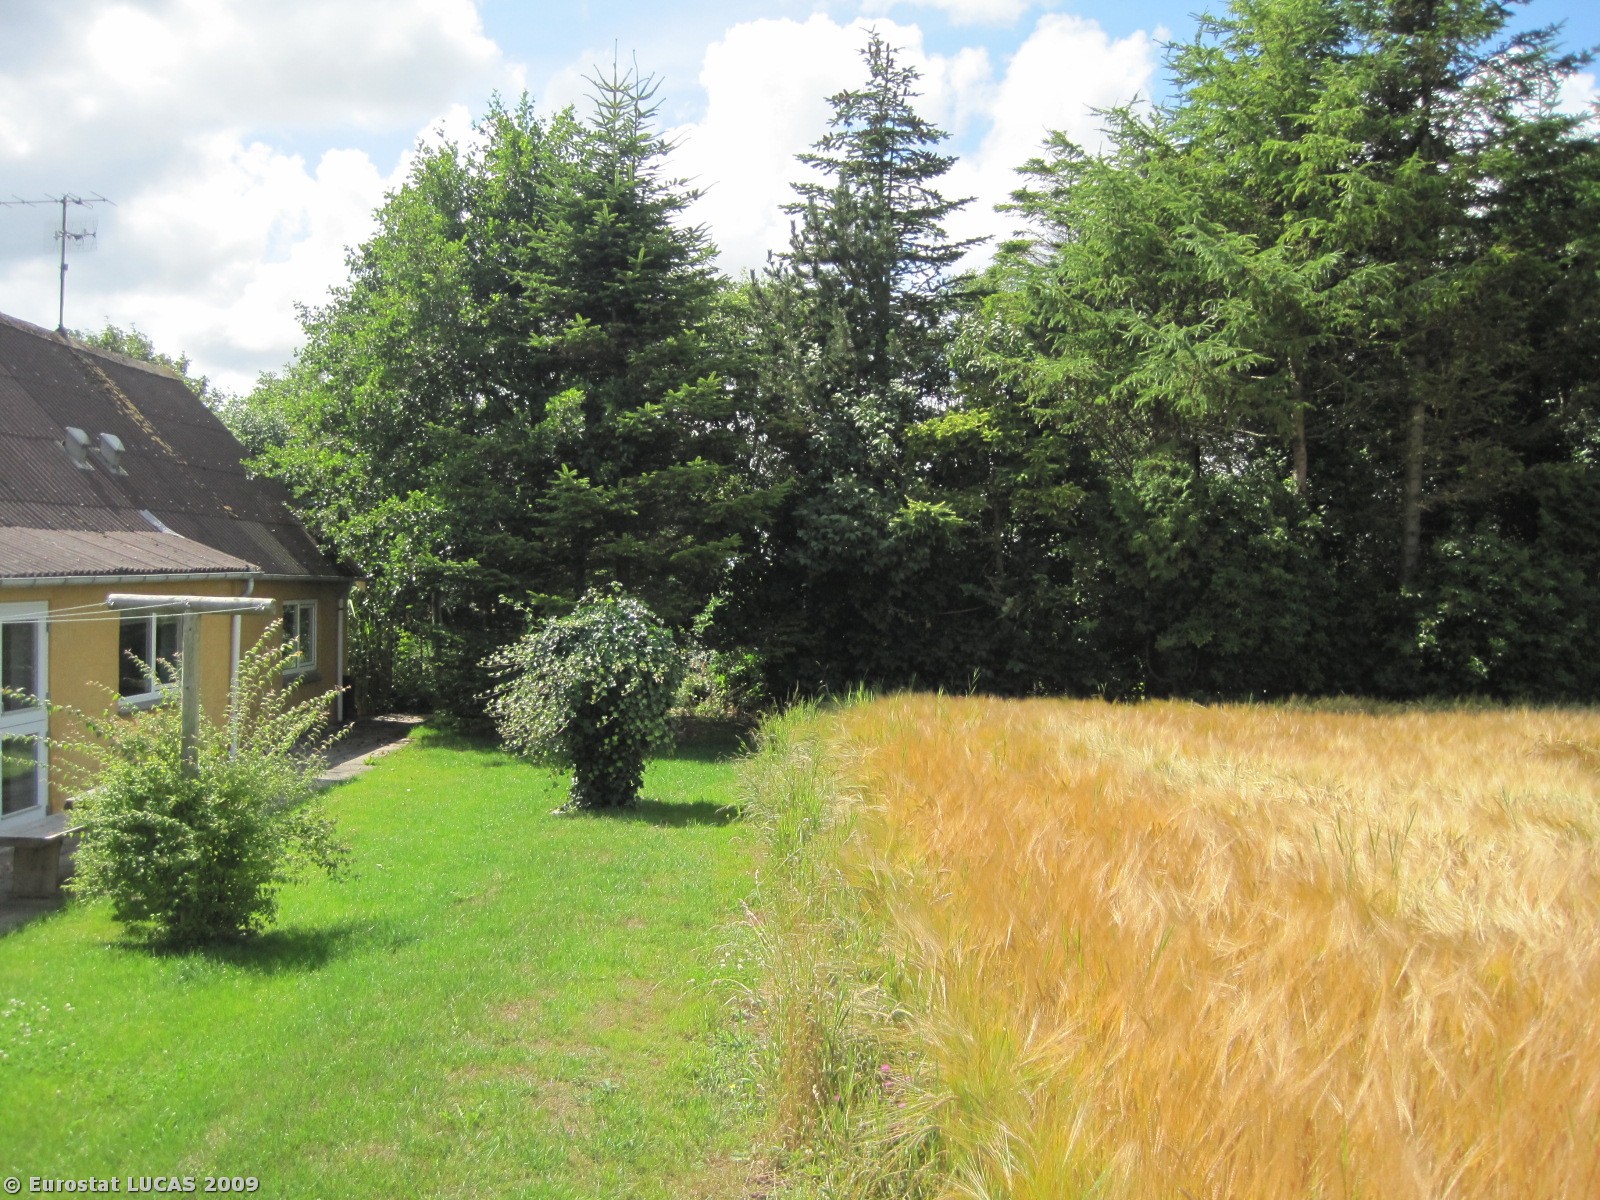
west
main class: Cropland
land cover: Barley
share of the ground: > 75 %
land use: Agriculture (excluding fallow land and kitchen gardens)
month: July
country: DK
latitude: 56.9726
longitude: 8.7351
